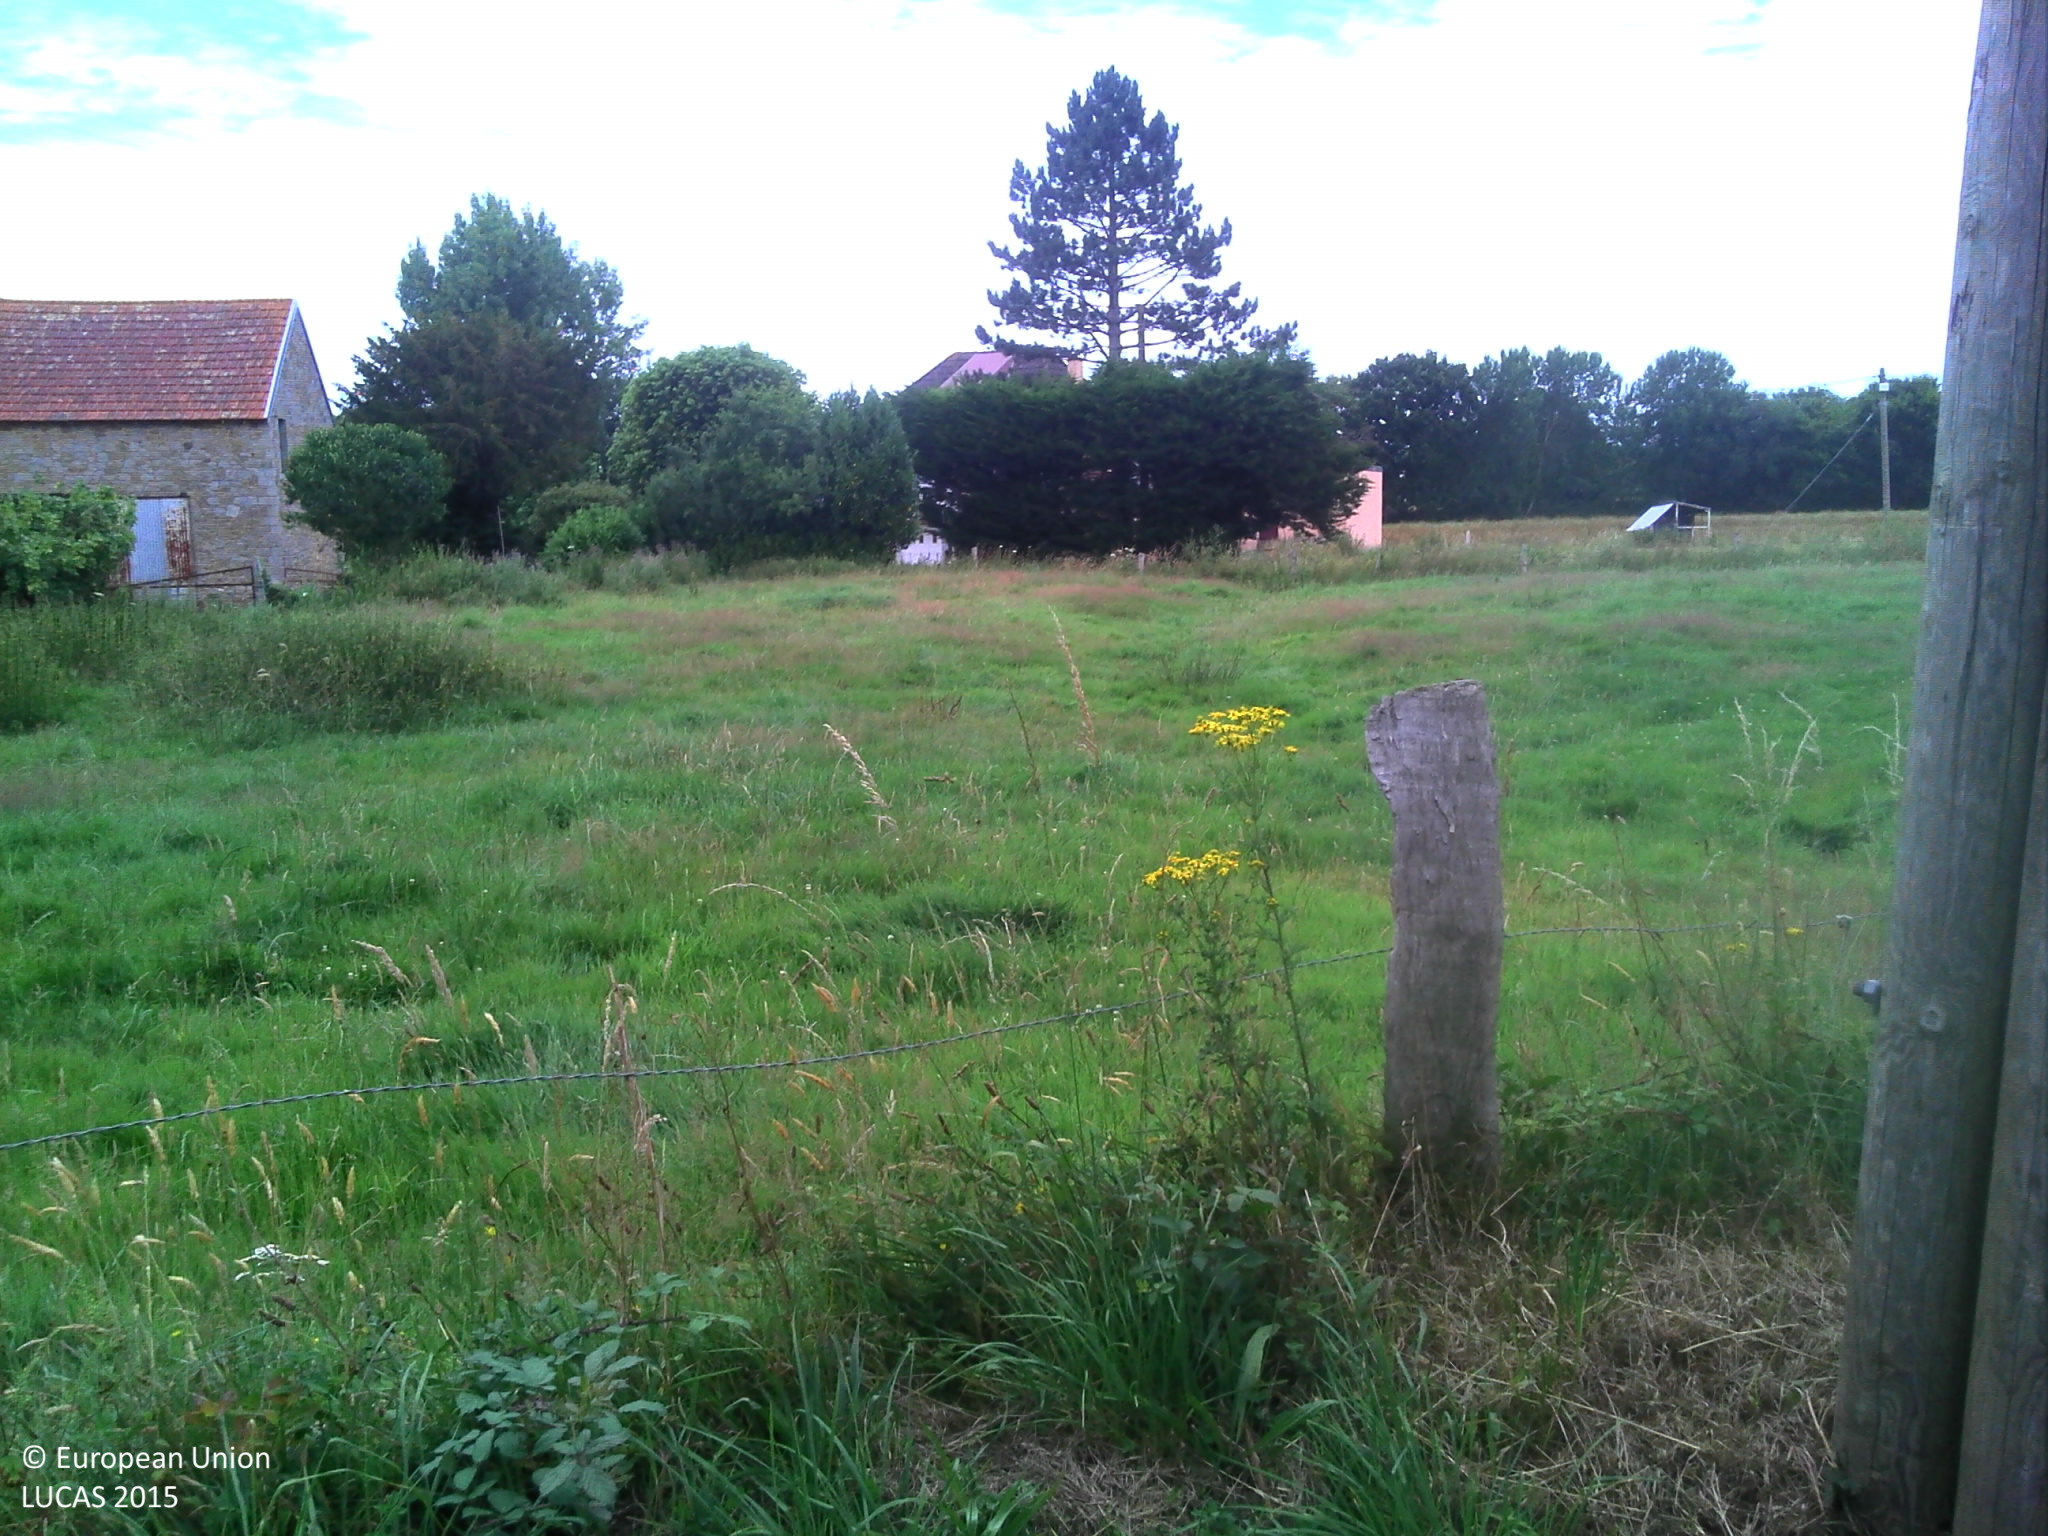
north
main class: Grassland
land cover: Grassland without tree/shrub cover
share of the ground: > 75 %
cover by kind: herbaceous plants 100 %
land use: Agriculture (excluding fallow land and kitchen gardens)
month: July
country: FR
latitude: 48.7599
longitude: -1.5433
